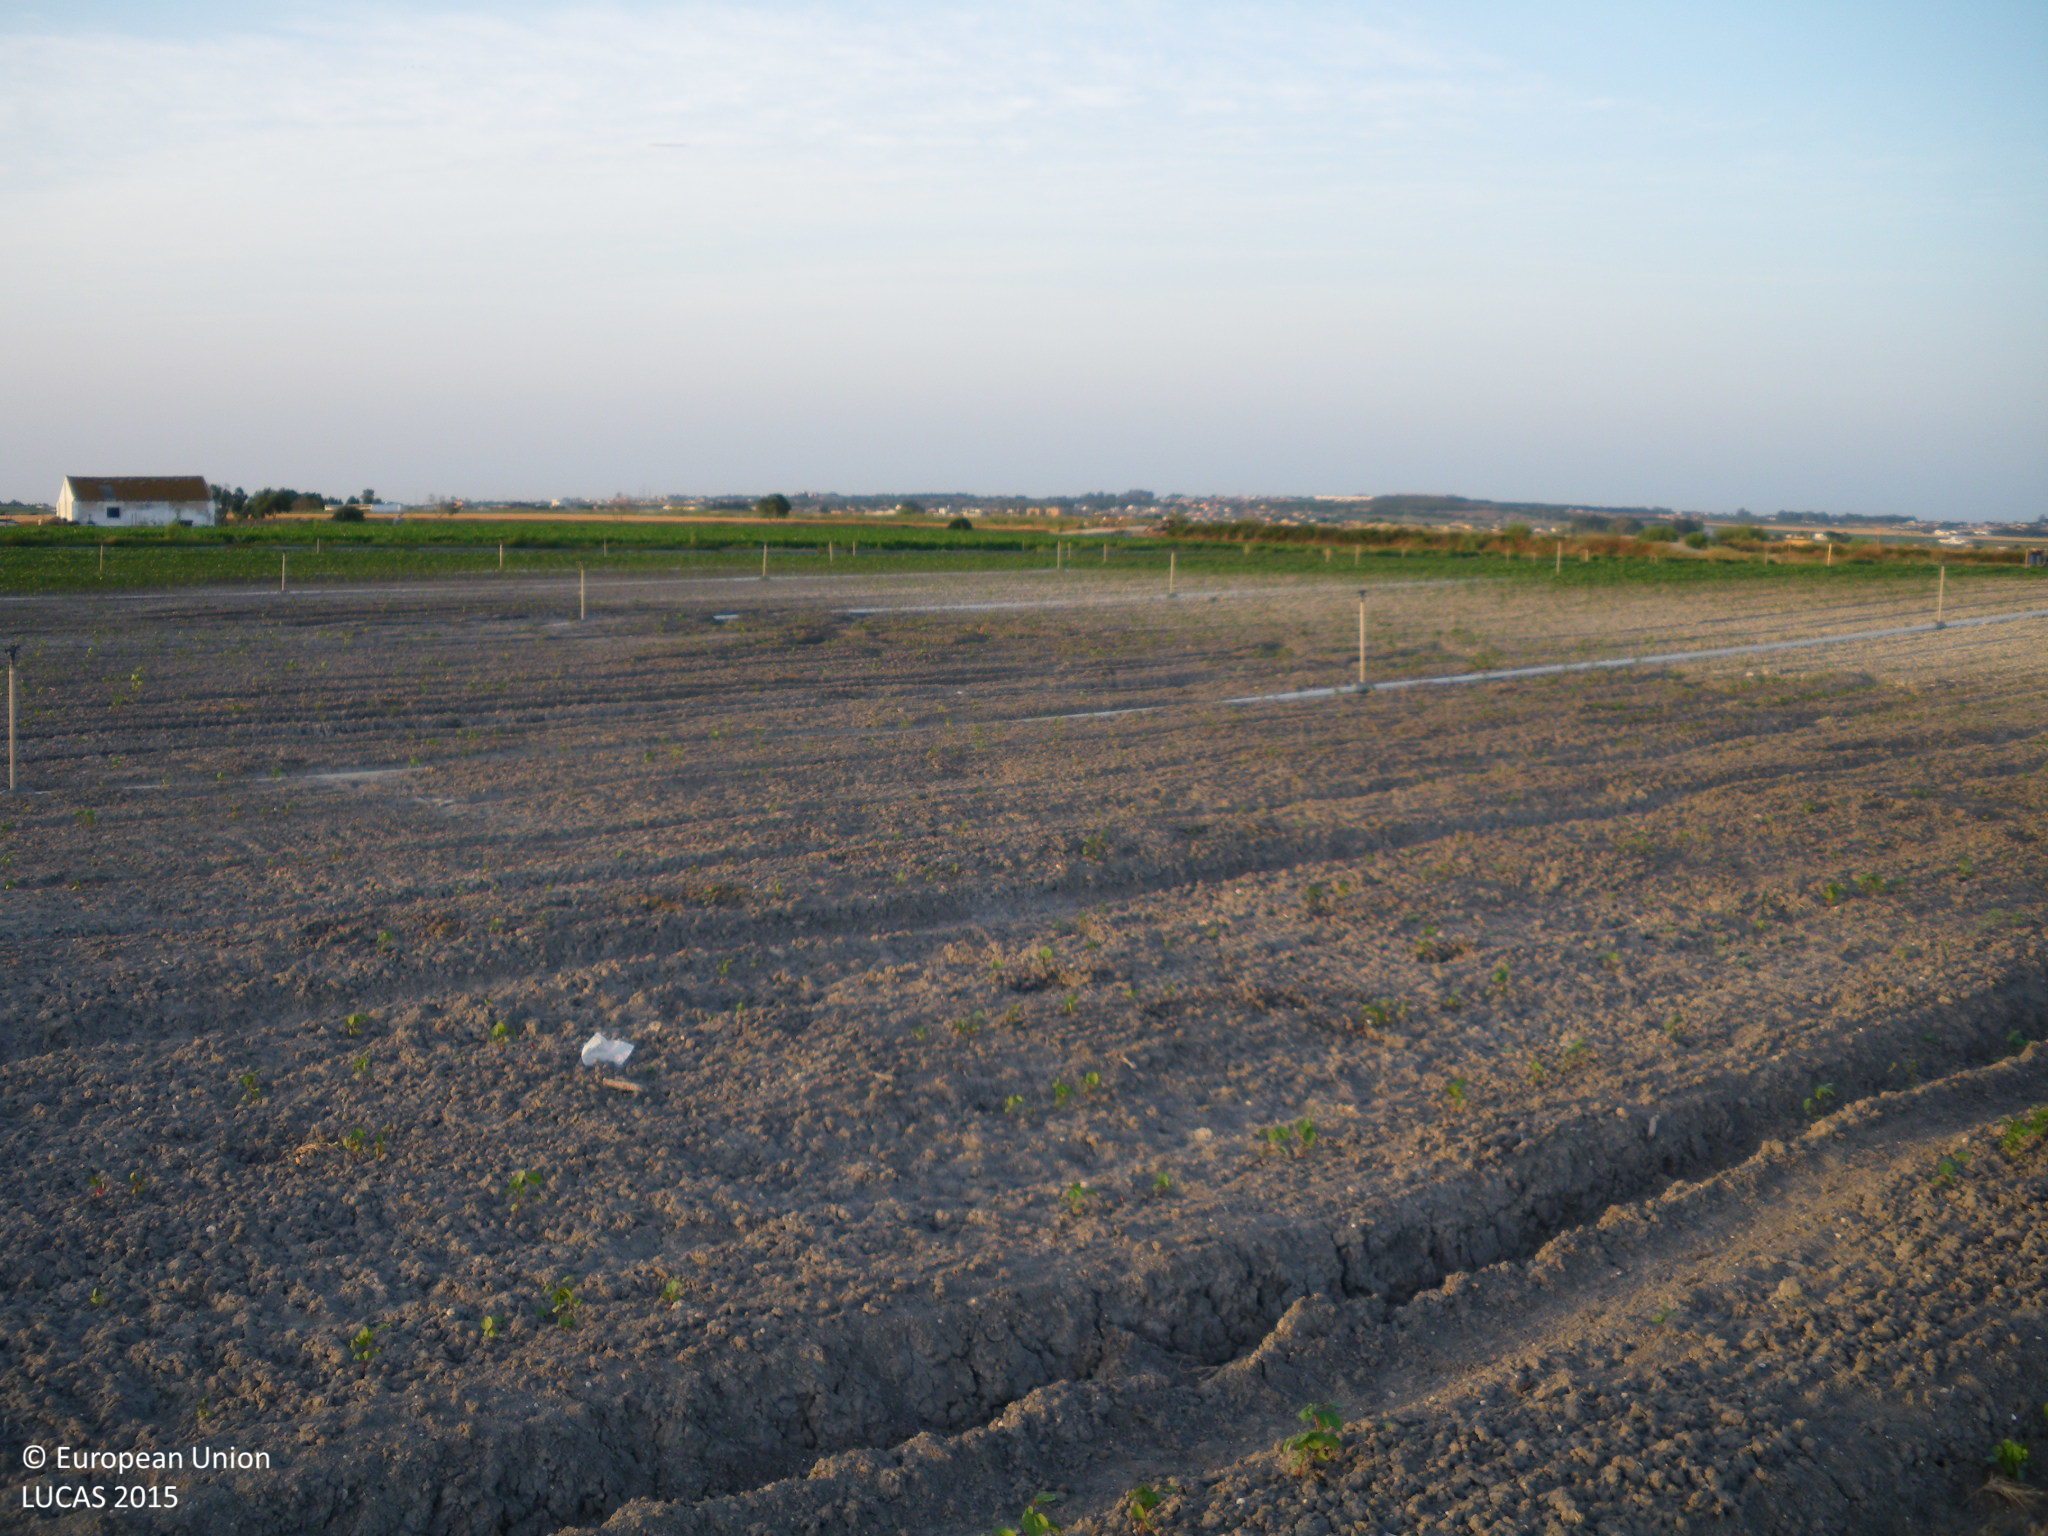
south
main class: Cropland
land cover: Cotton
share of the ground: < 10 %
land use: Agriculture (excluding fallow land and kitchen gardens)
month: June
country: ES
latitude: 36.6543
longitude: -6.2451
